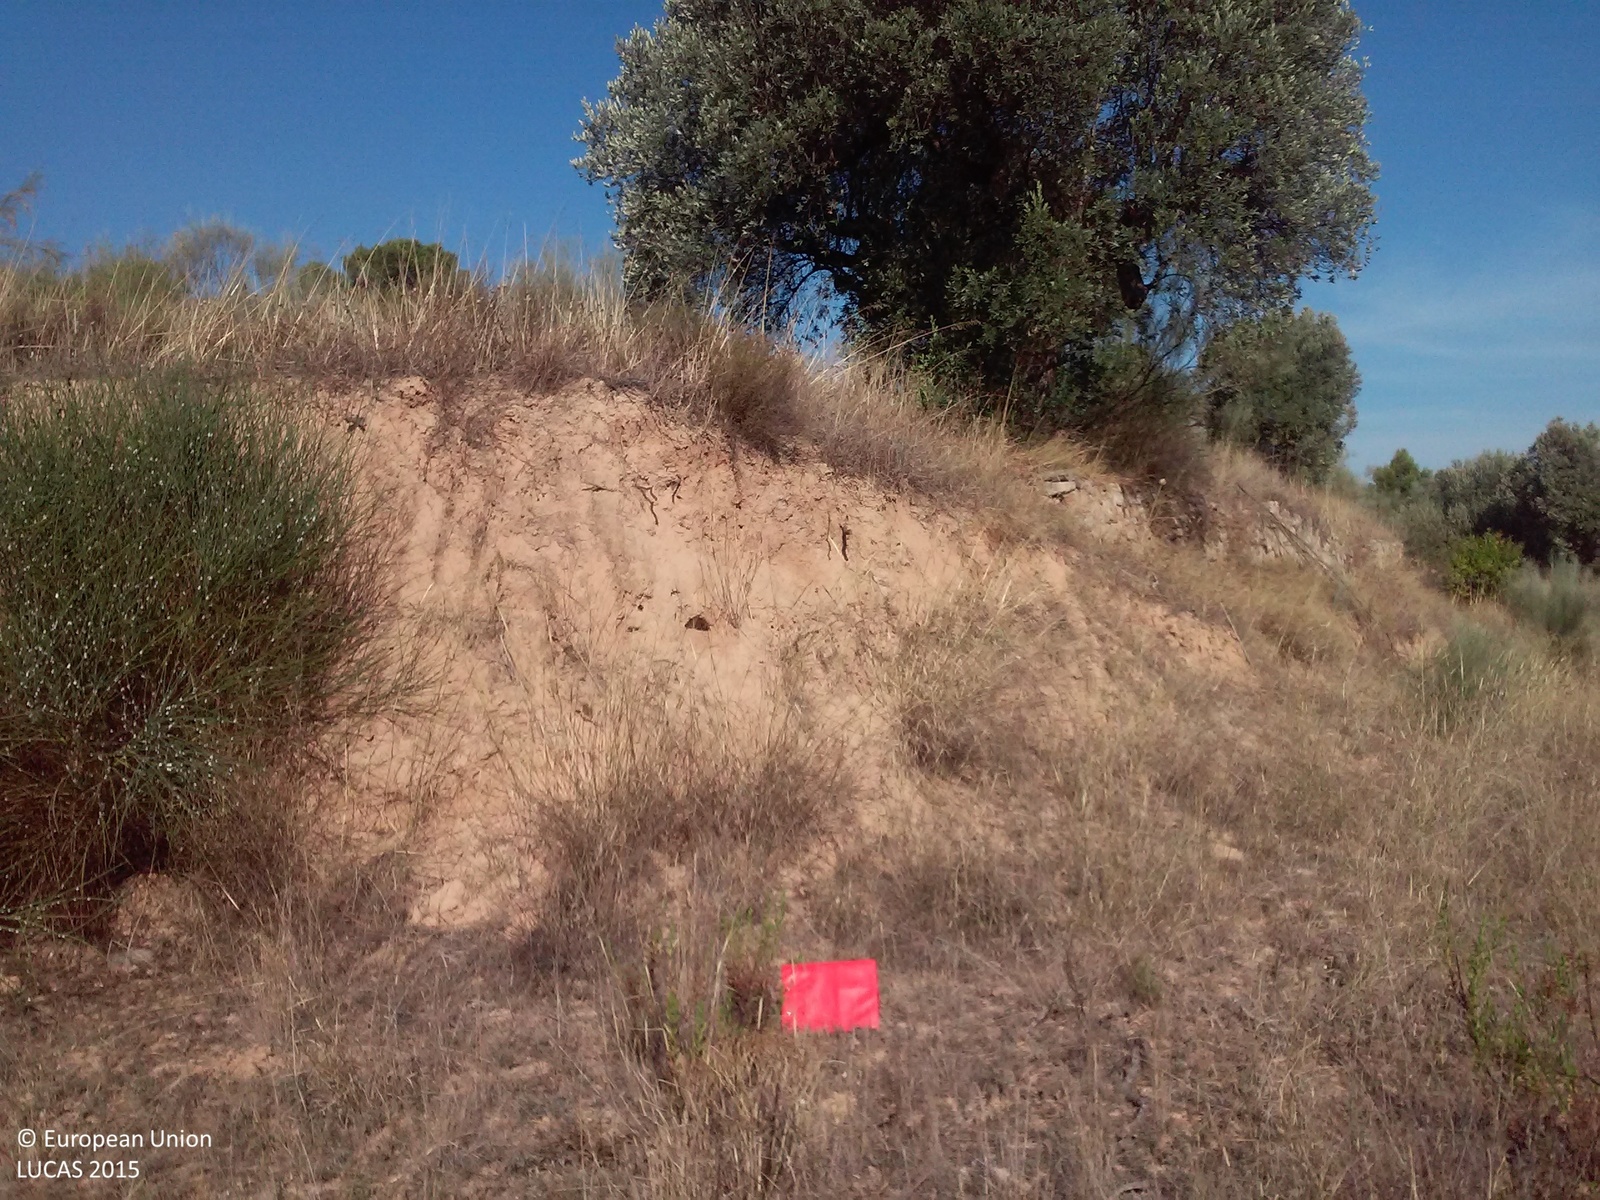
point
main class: Grassland
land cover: Grassland without tree/shrub cover
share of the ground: 25 - 50 %
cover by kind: herbaceous plants 95 %, shrubs 5 %
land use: Semi-natural and natural areas not in use
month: August
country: ES
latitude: 41.2277
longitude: 0.5302
